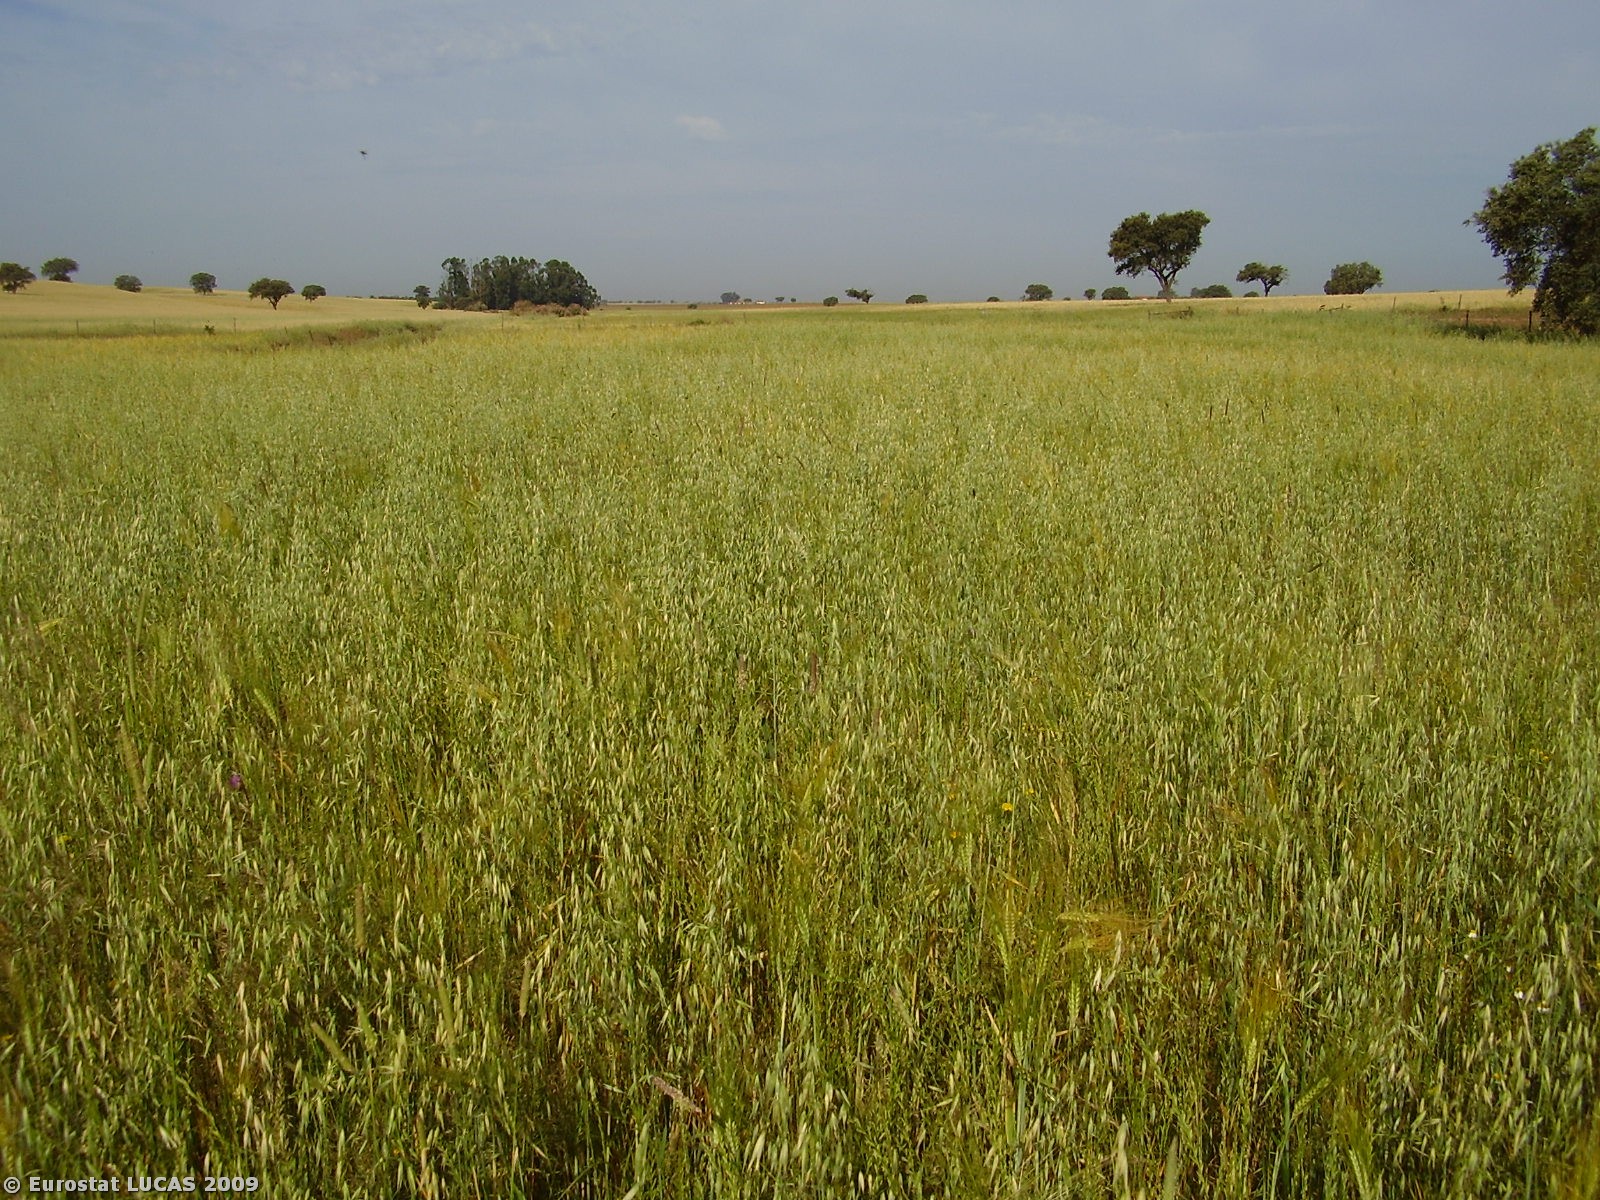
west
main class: Cropland
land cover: Mixed cereals for fodder
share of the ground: > 75 %
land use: Agriculture (excluding fallow land and kitchen gardens)
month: May
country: PT
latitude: 37.9531
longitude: -7.9299
